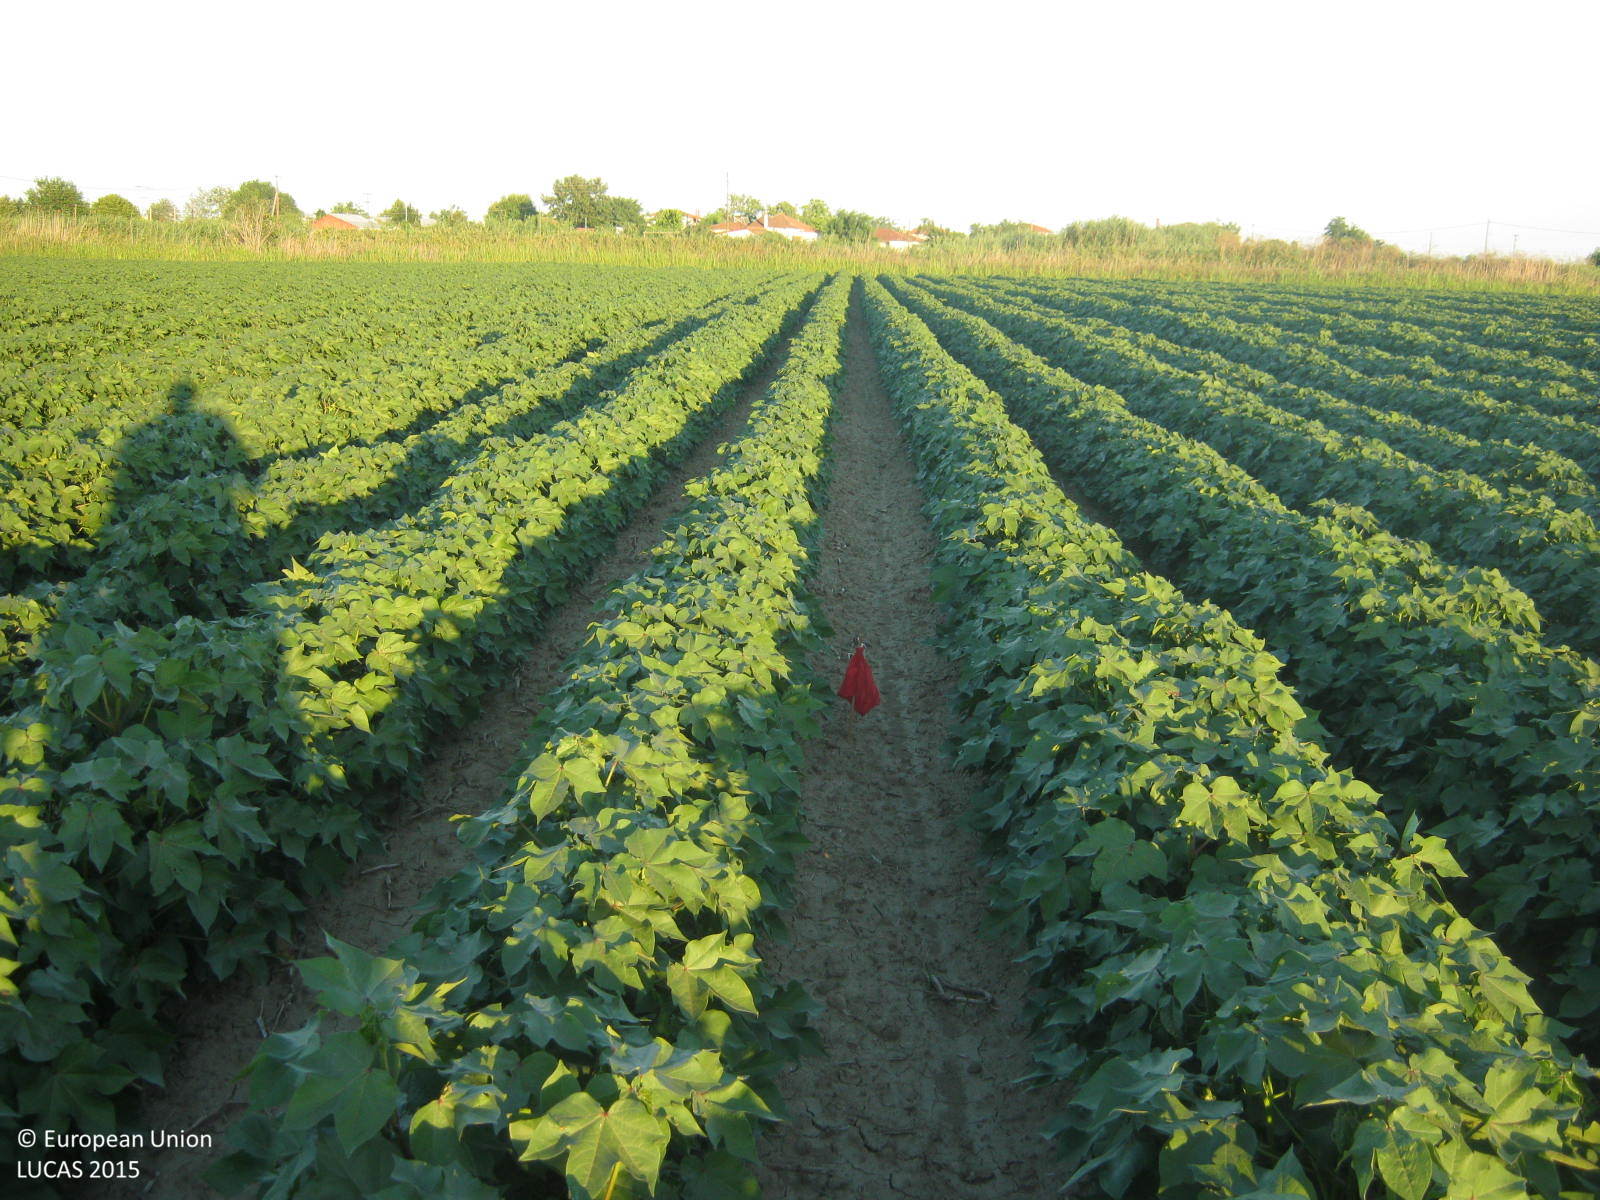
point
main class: Cropland
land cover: Cotton
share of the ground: > 75 %
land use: Agriculture (excluding fallow land and kitchen gardens)
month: July
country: GR
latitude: 40.5691
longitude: 22.5820
